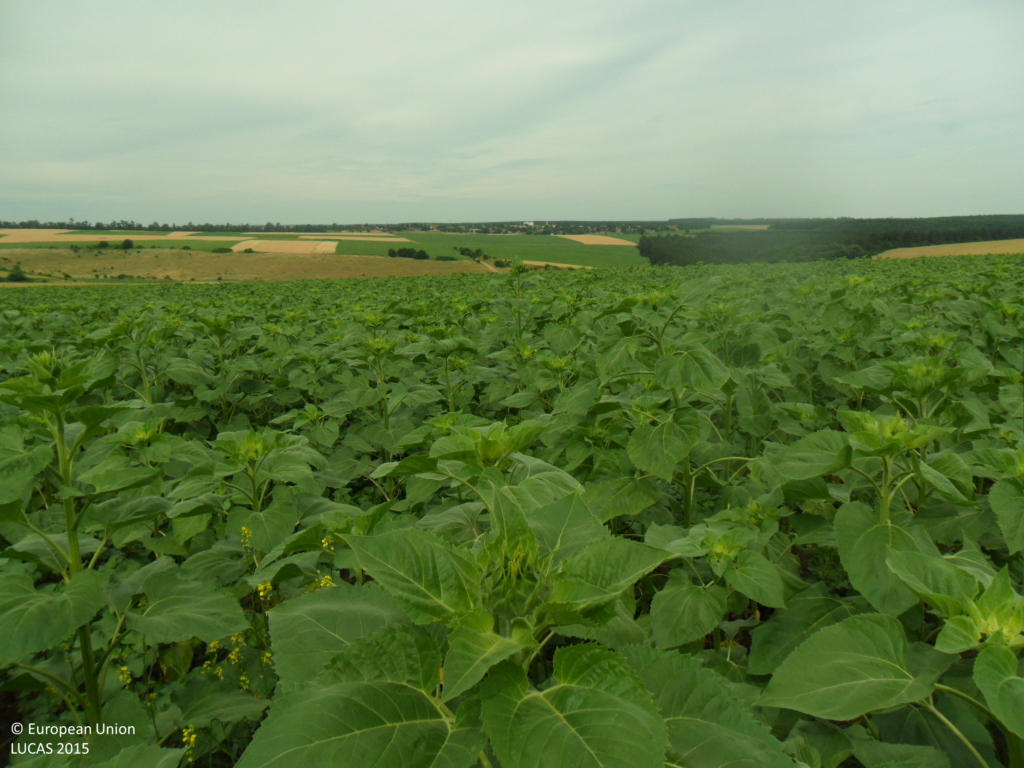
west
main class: Cropland
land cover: Sunflower
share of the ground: > 75 %
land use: Agriculture (excluding fallow land and kitchen gardens)
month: June
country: BG
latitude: 43.7105
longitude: 26.9857
